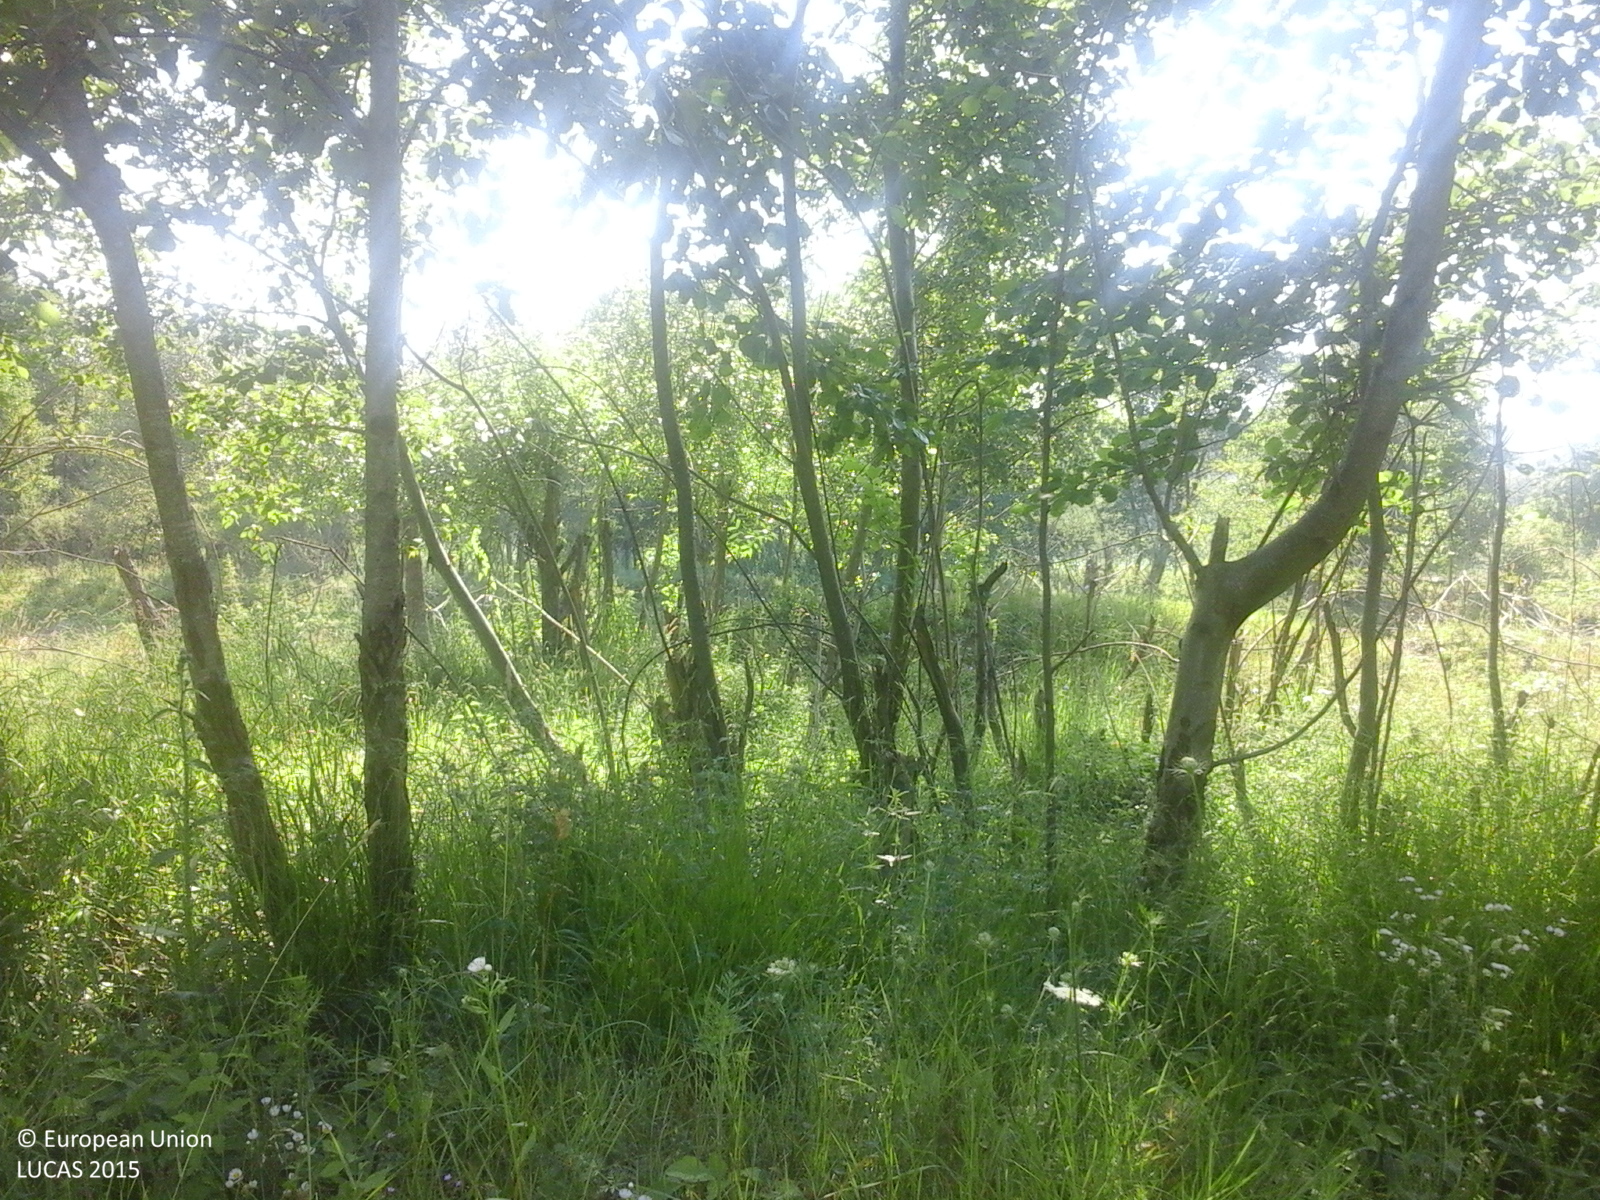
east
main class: Woodland
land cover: Broadleaved woodland
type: beech forest
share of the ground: > 75 %
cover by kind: broadleaved forest trees 100 %
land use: Forestry
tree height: > 5 m
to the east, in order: Broadleaved woodland; Rocks and stones; Inland fresh running water; Rocks and stones; Broadleaved woodland; Spontaneously vegetated surfaces; Tracks; Grassland with sparse tree/shrub cover; Maize; Electric lines; Maize; Lucerne; Grassland without tree/shrub cover; Single bushes/trees; Spontaneously vegetated surfaces; Fences; Abandoned hedges; Spontaneously vegetated surfaces; Other fruit trees and berries
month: July
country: RO
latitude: 45.1245
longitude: 25.1034
